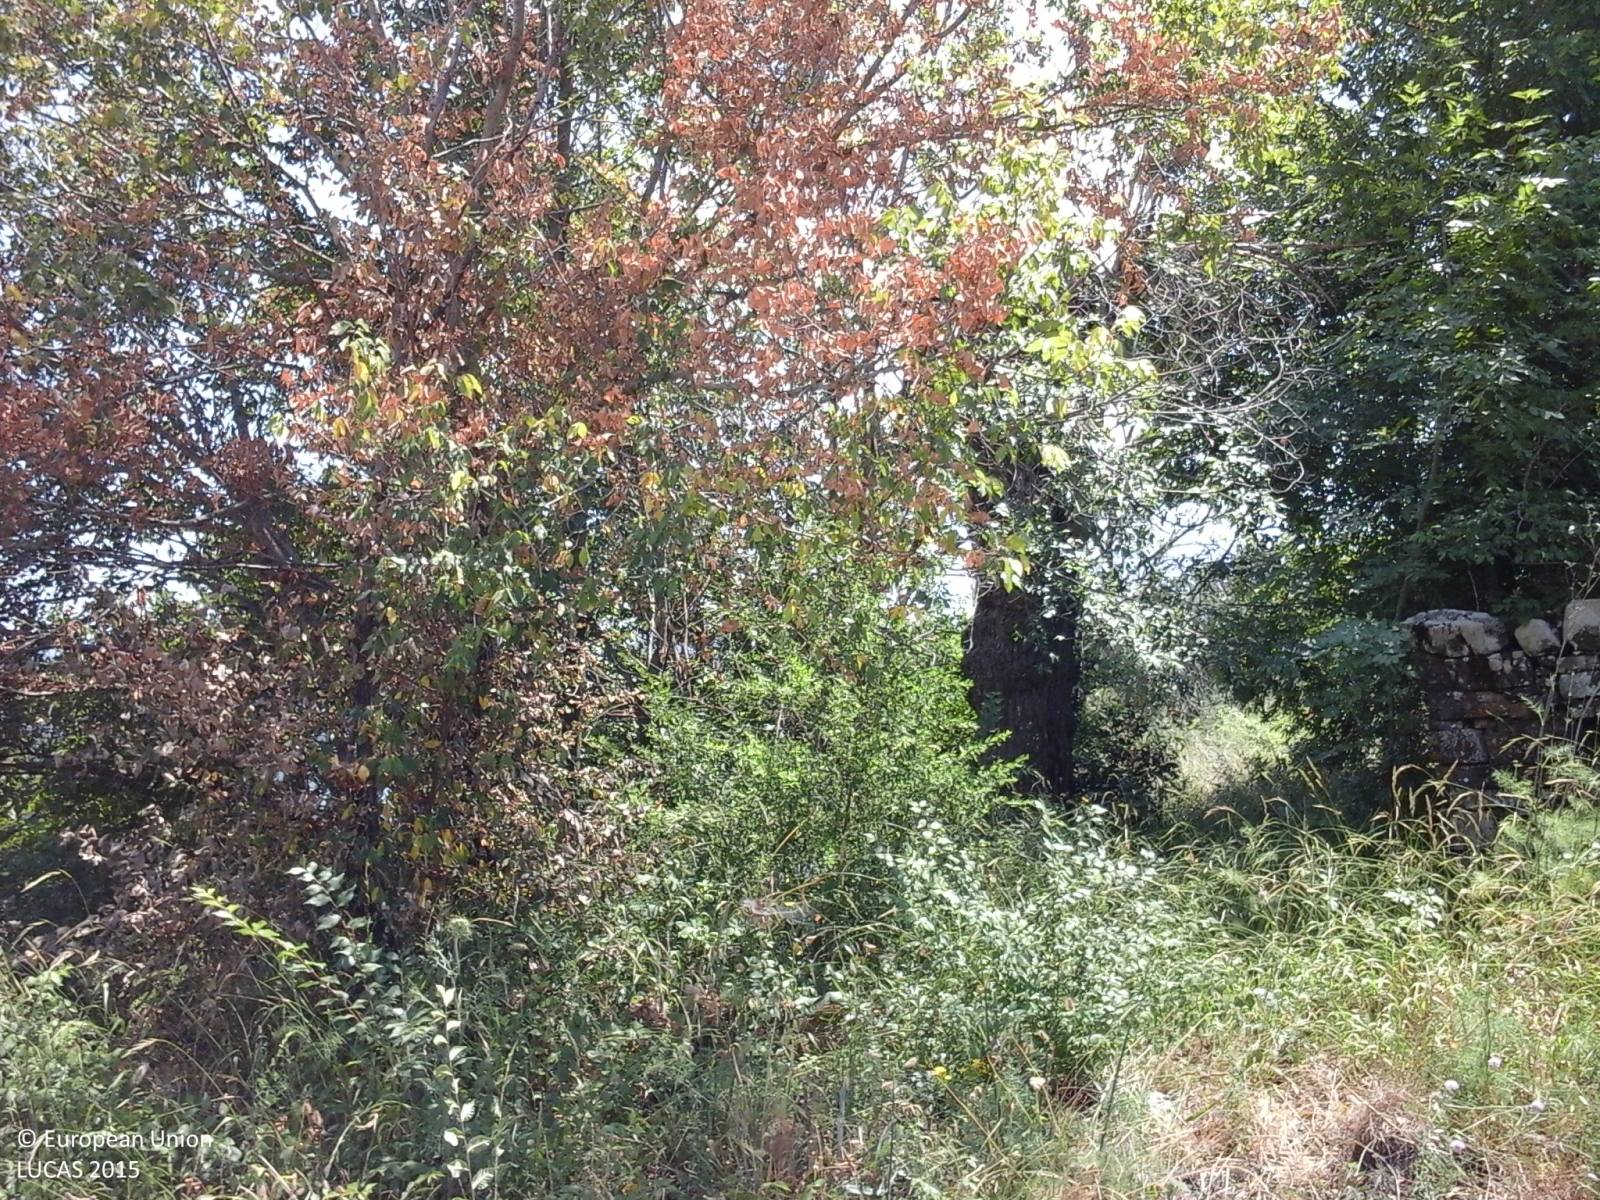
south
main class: Shrubland
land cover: Shrubland with sparse tree cover
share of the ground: > 75 %
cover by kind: shrubs 85 %, broadleaved forest trees 5 %
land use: Semi-natural and natural areas not in use
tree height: > 5 m
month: June
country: IT
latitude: 40.3342
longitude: 15.0981
